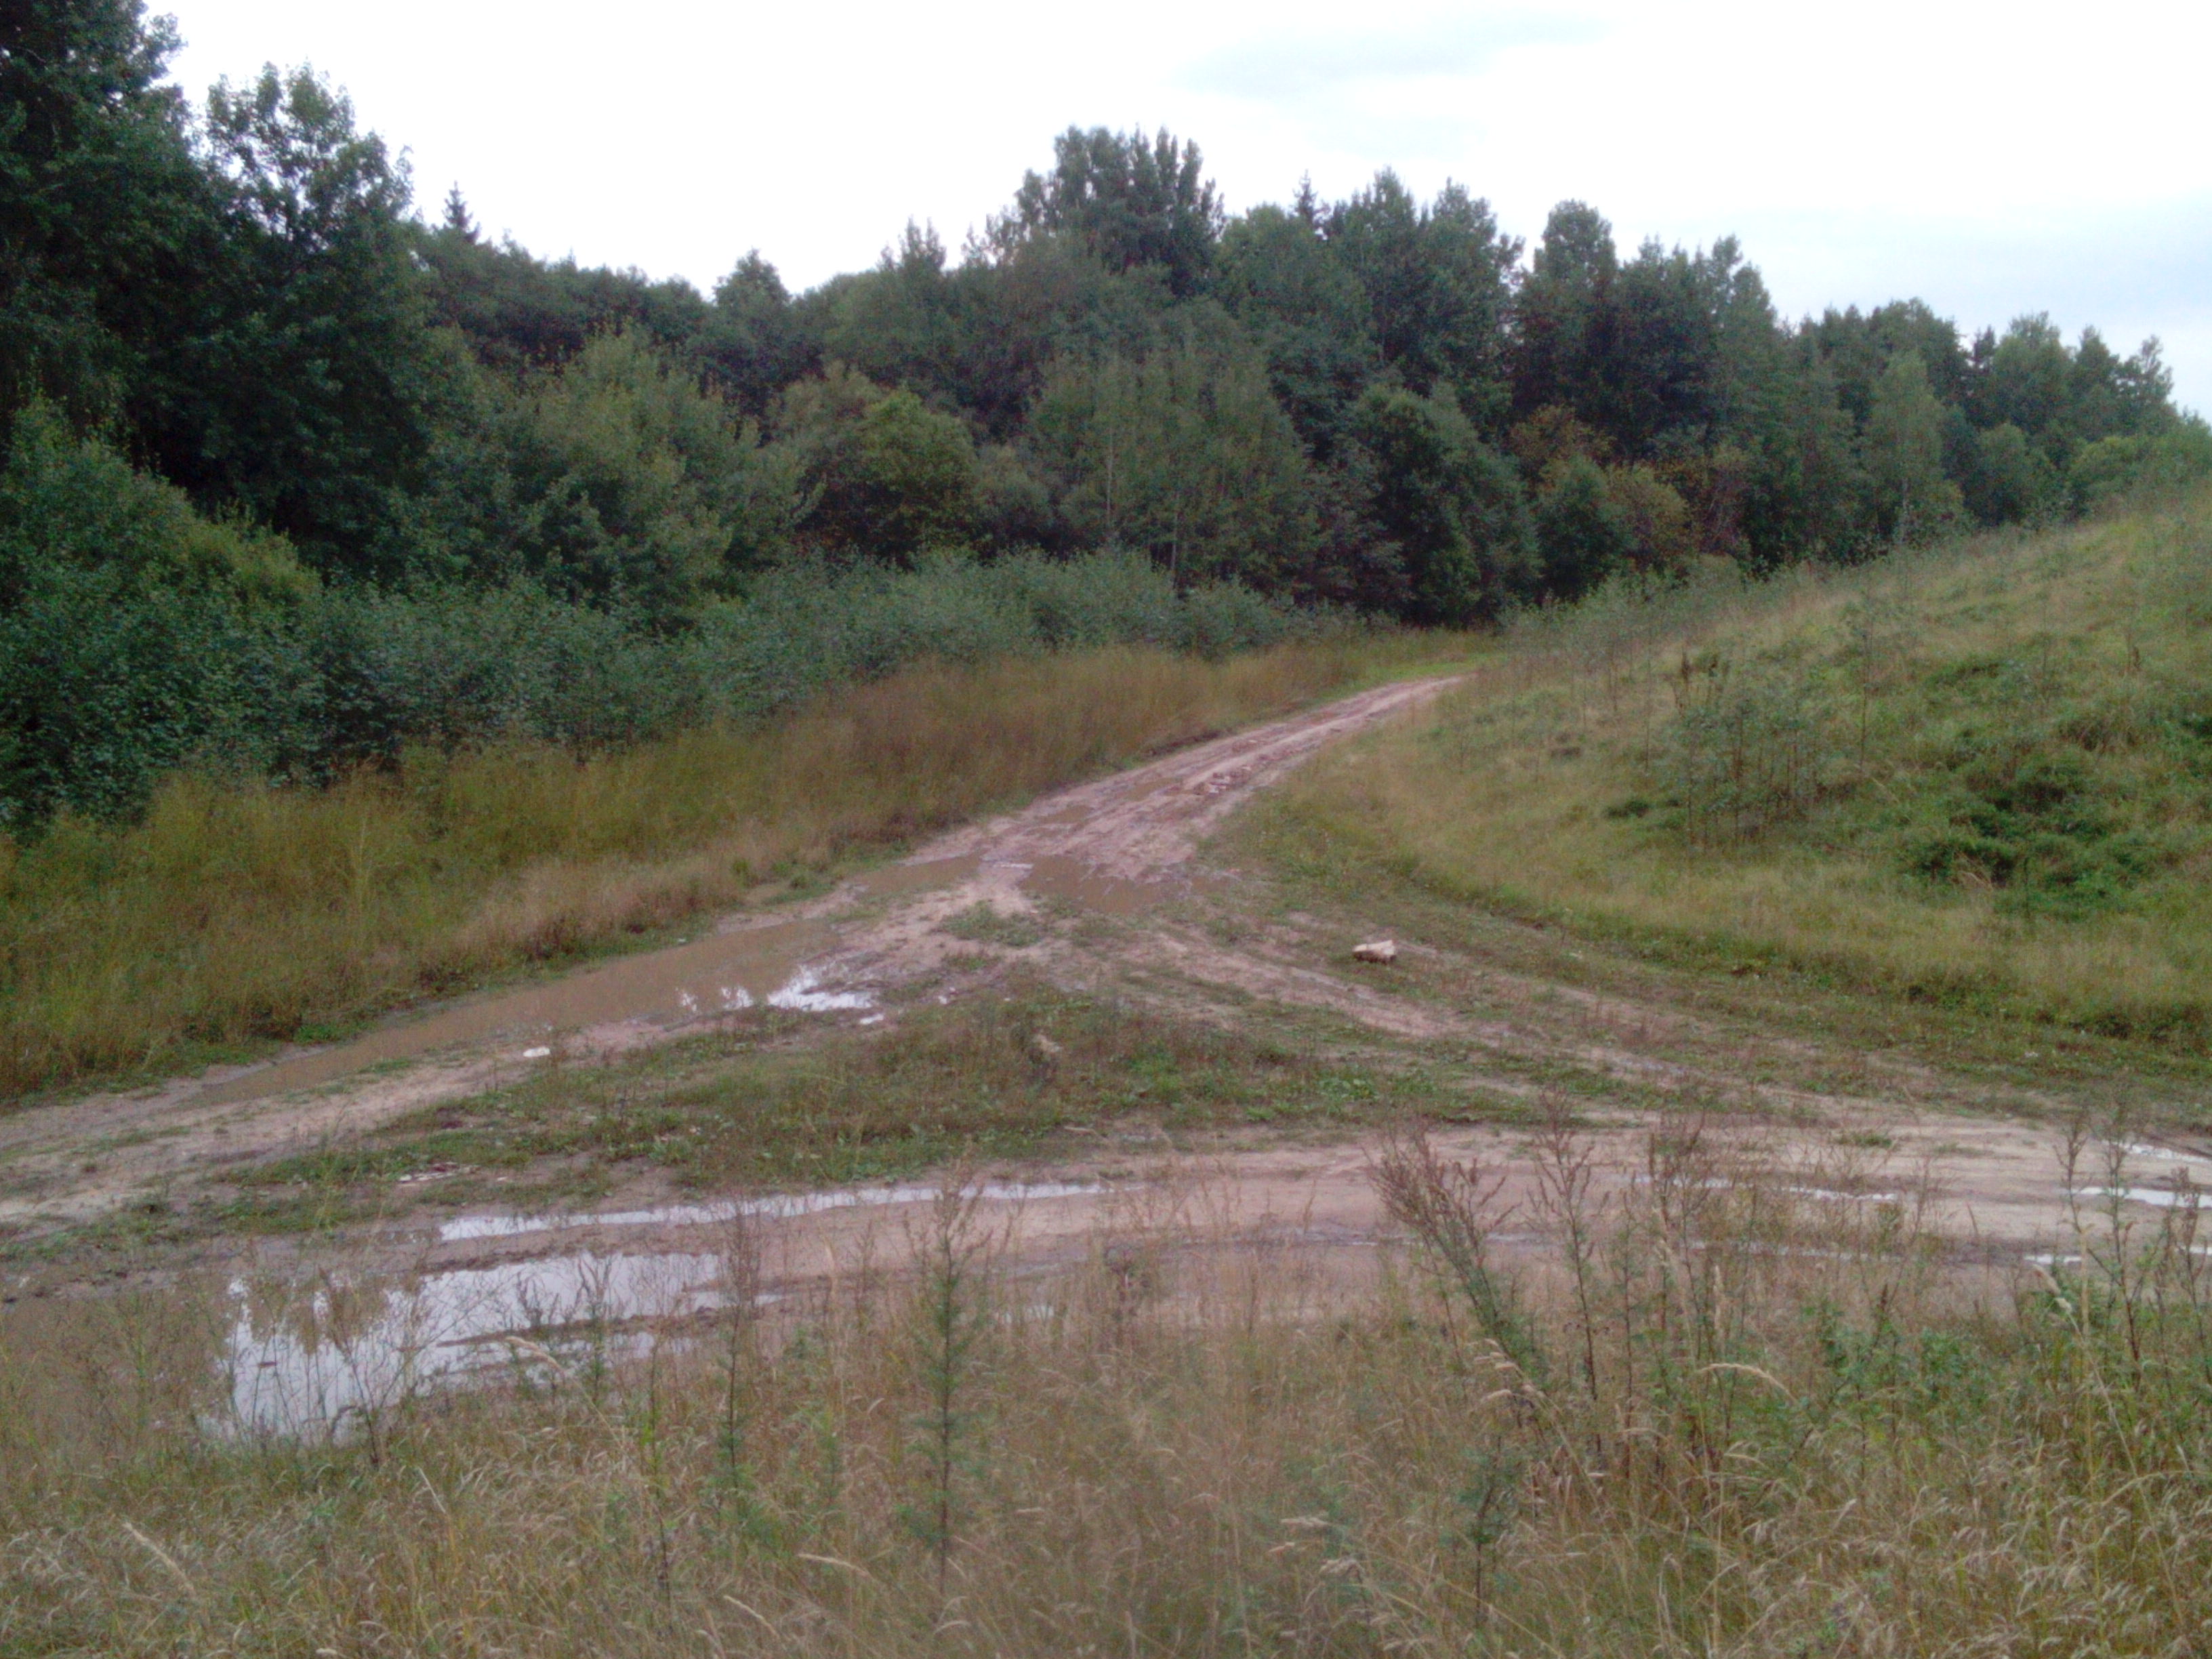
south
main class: Grassland
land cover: Spontaneously vegetated surfaces
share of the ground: > 75 %
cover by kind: herbaceous plants 100 %
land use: Semi-natural and natural areas not in use
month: September
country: LT
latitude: 55.9178
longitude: 22.8827
